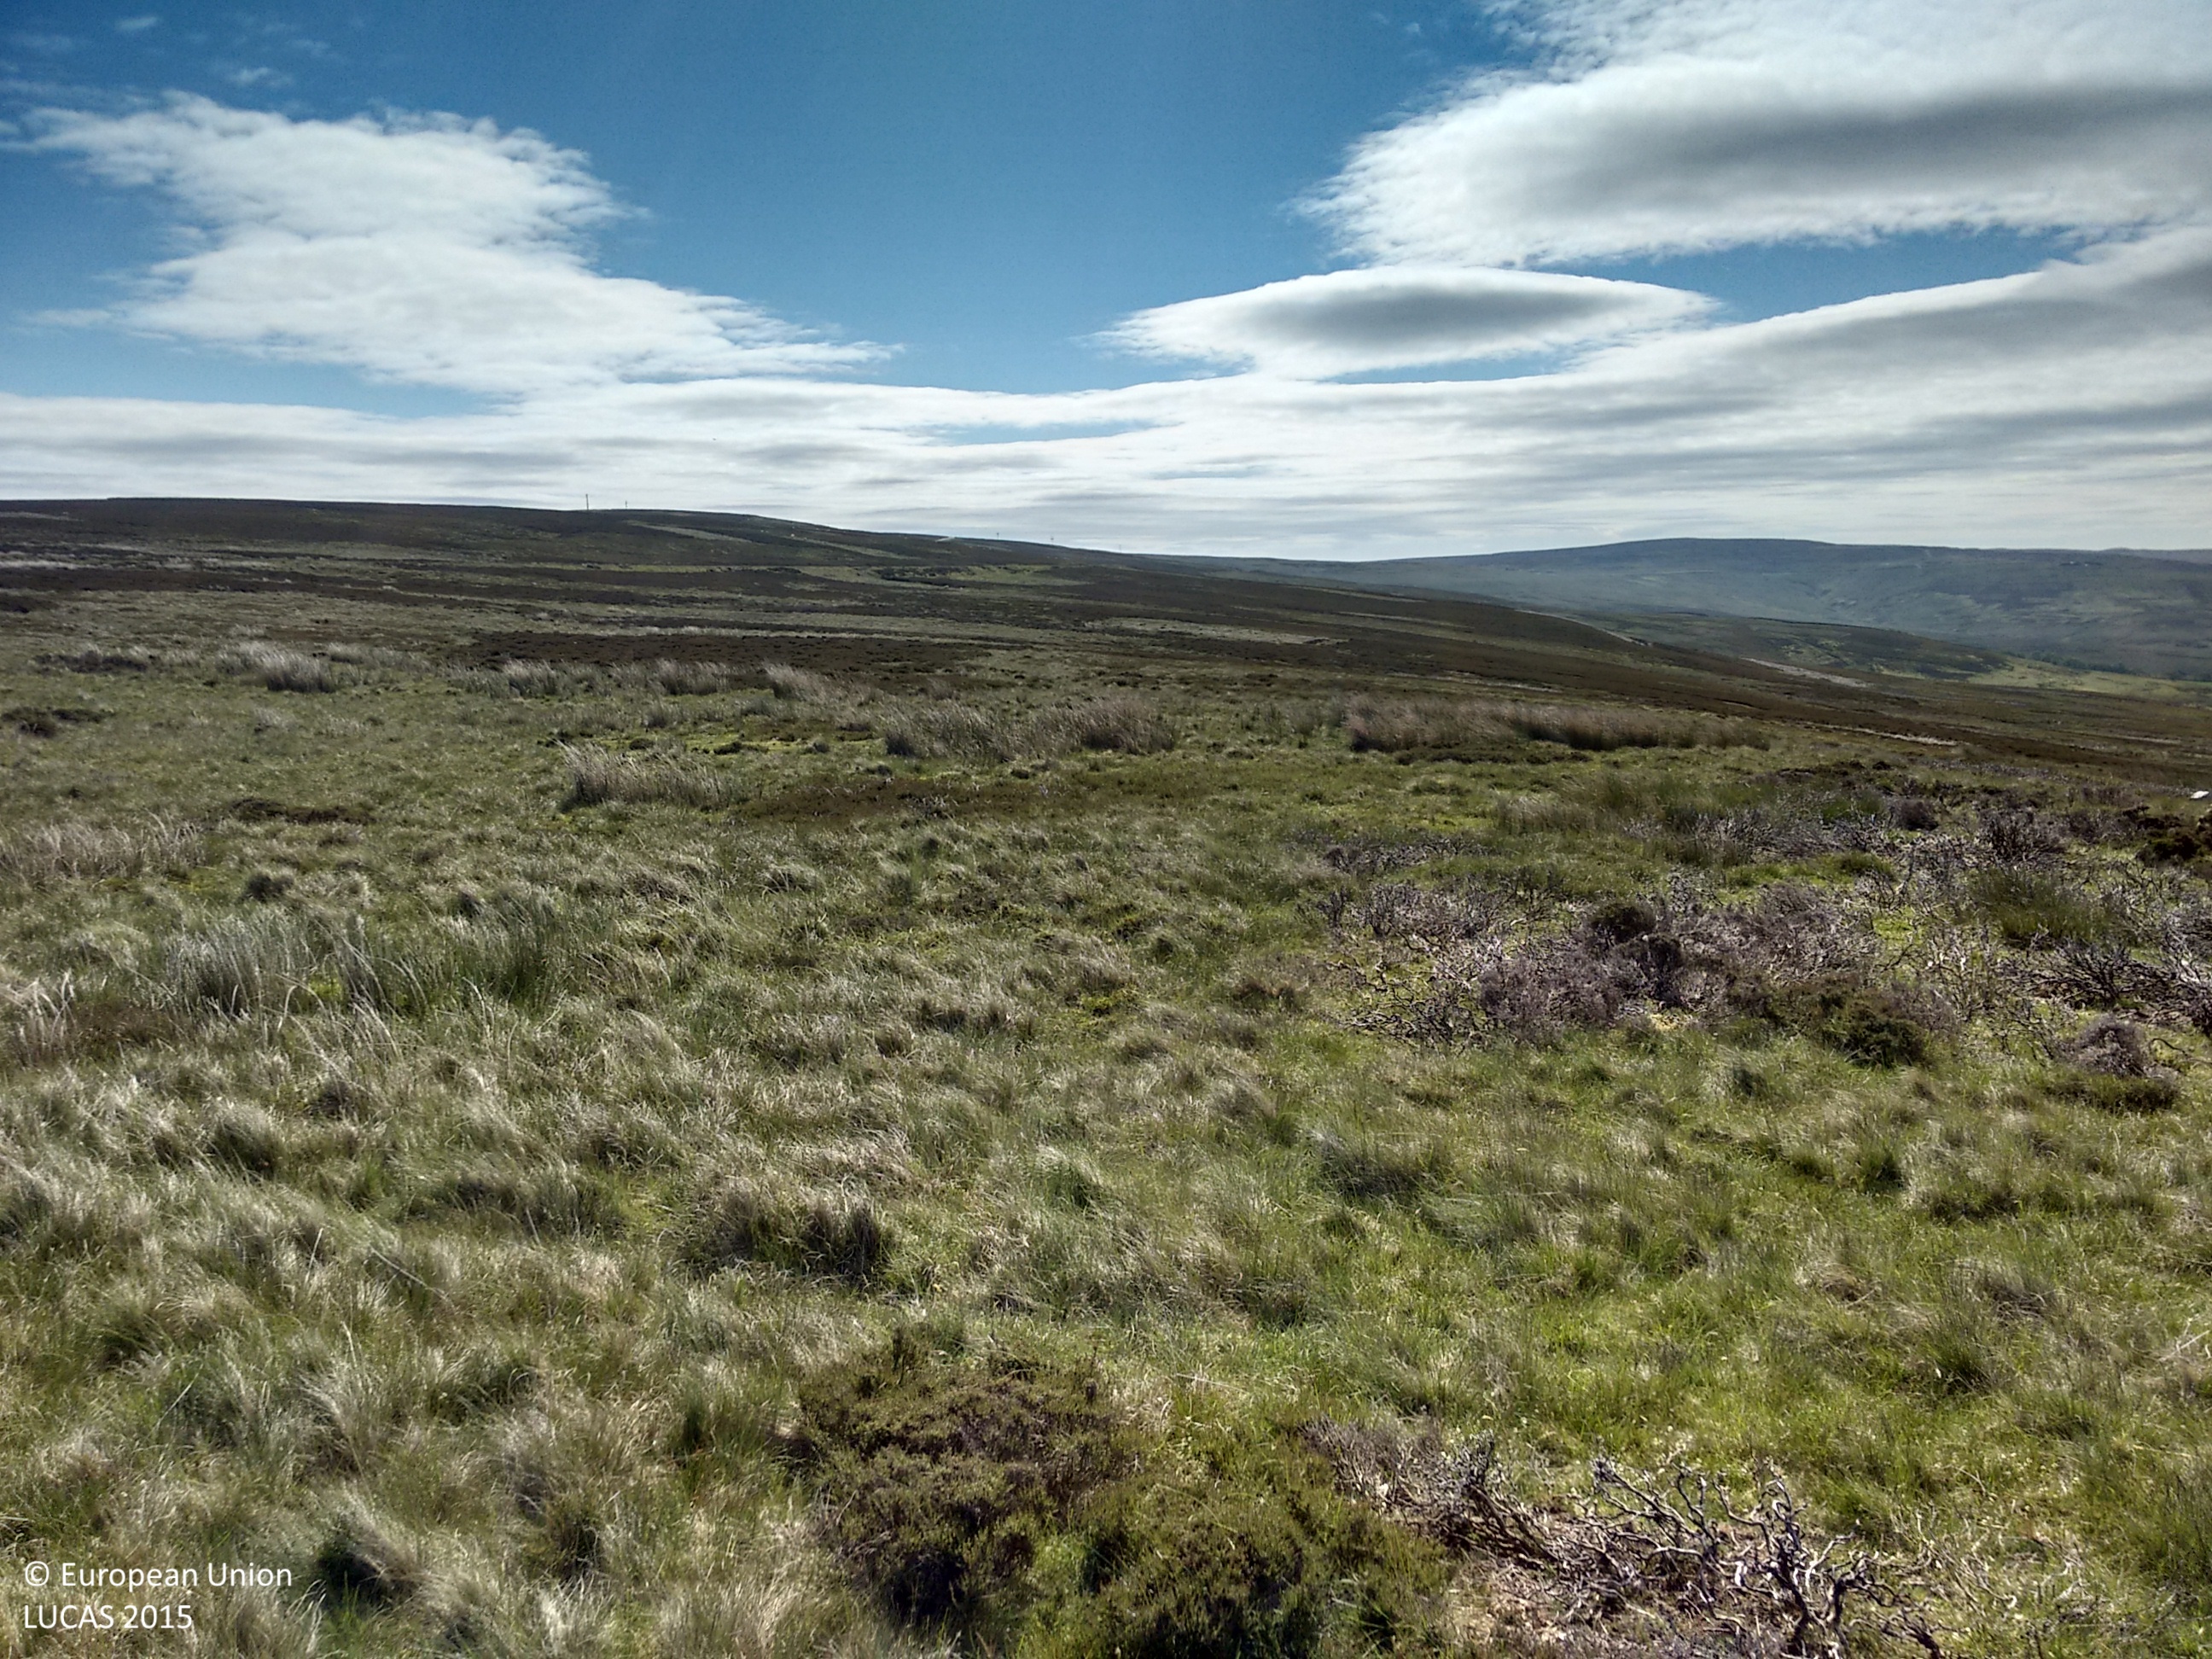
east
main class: Grassland
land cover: Grassland without tree/shrub cover
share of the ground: > 75 %
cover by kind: herbaceous plants 100 %
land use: Agriculture (excluding fallow land and kitchen gardens)
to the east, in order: Grassland without tree/shrub cover; Ditches and canals; Shrubland without tree cover; Grassland without tree/shrub cover
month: June
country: GB
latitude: 54.7986
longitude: -2.0488
